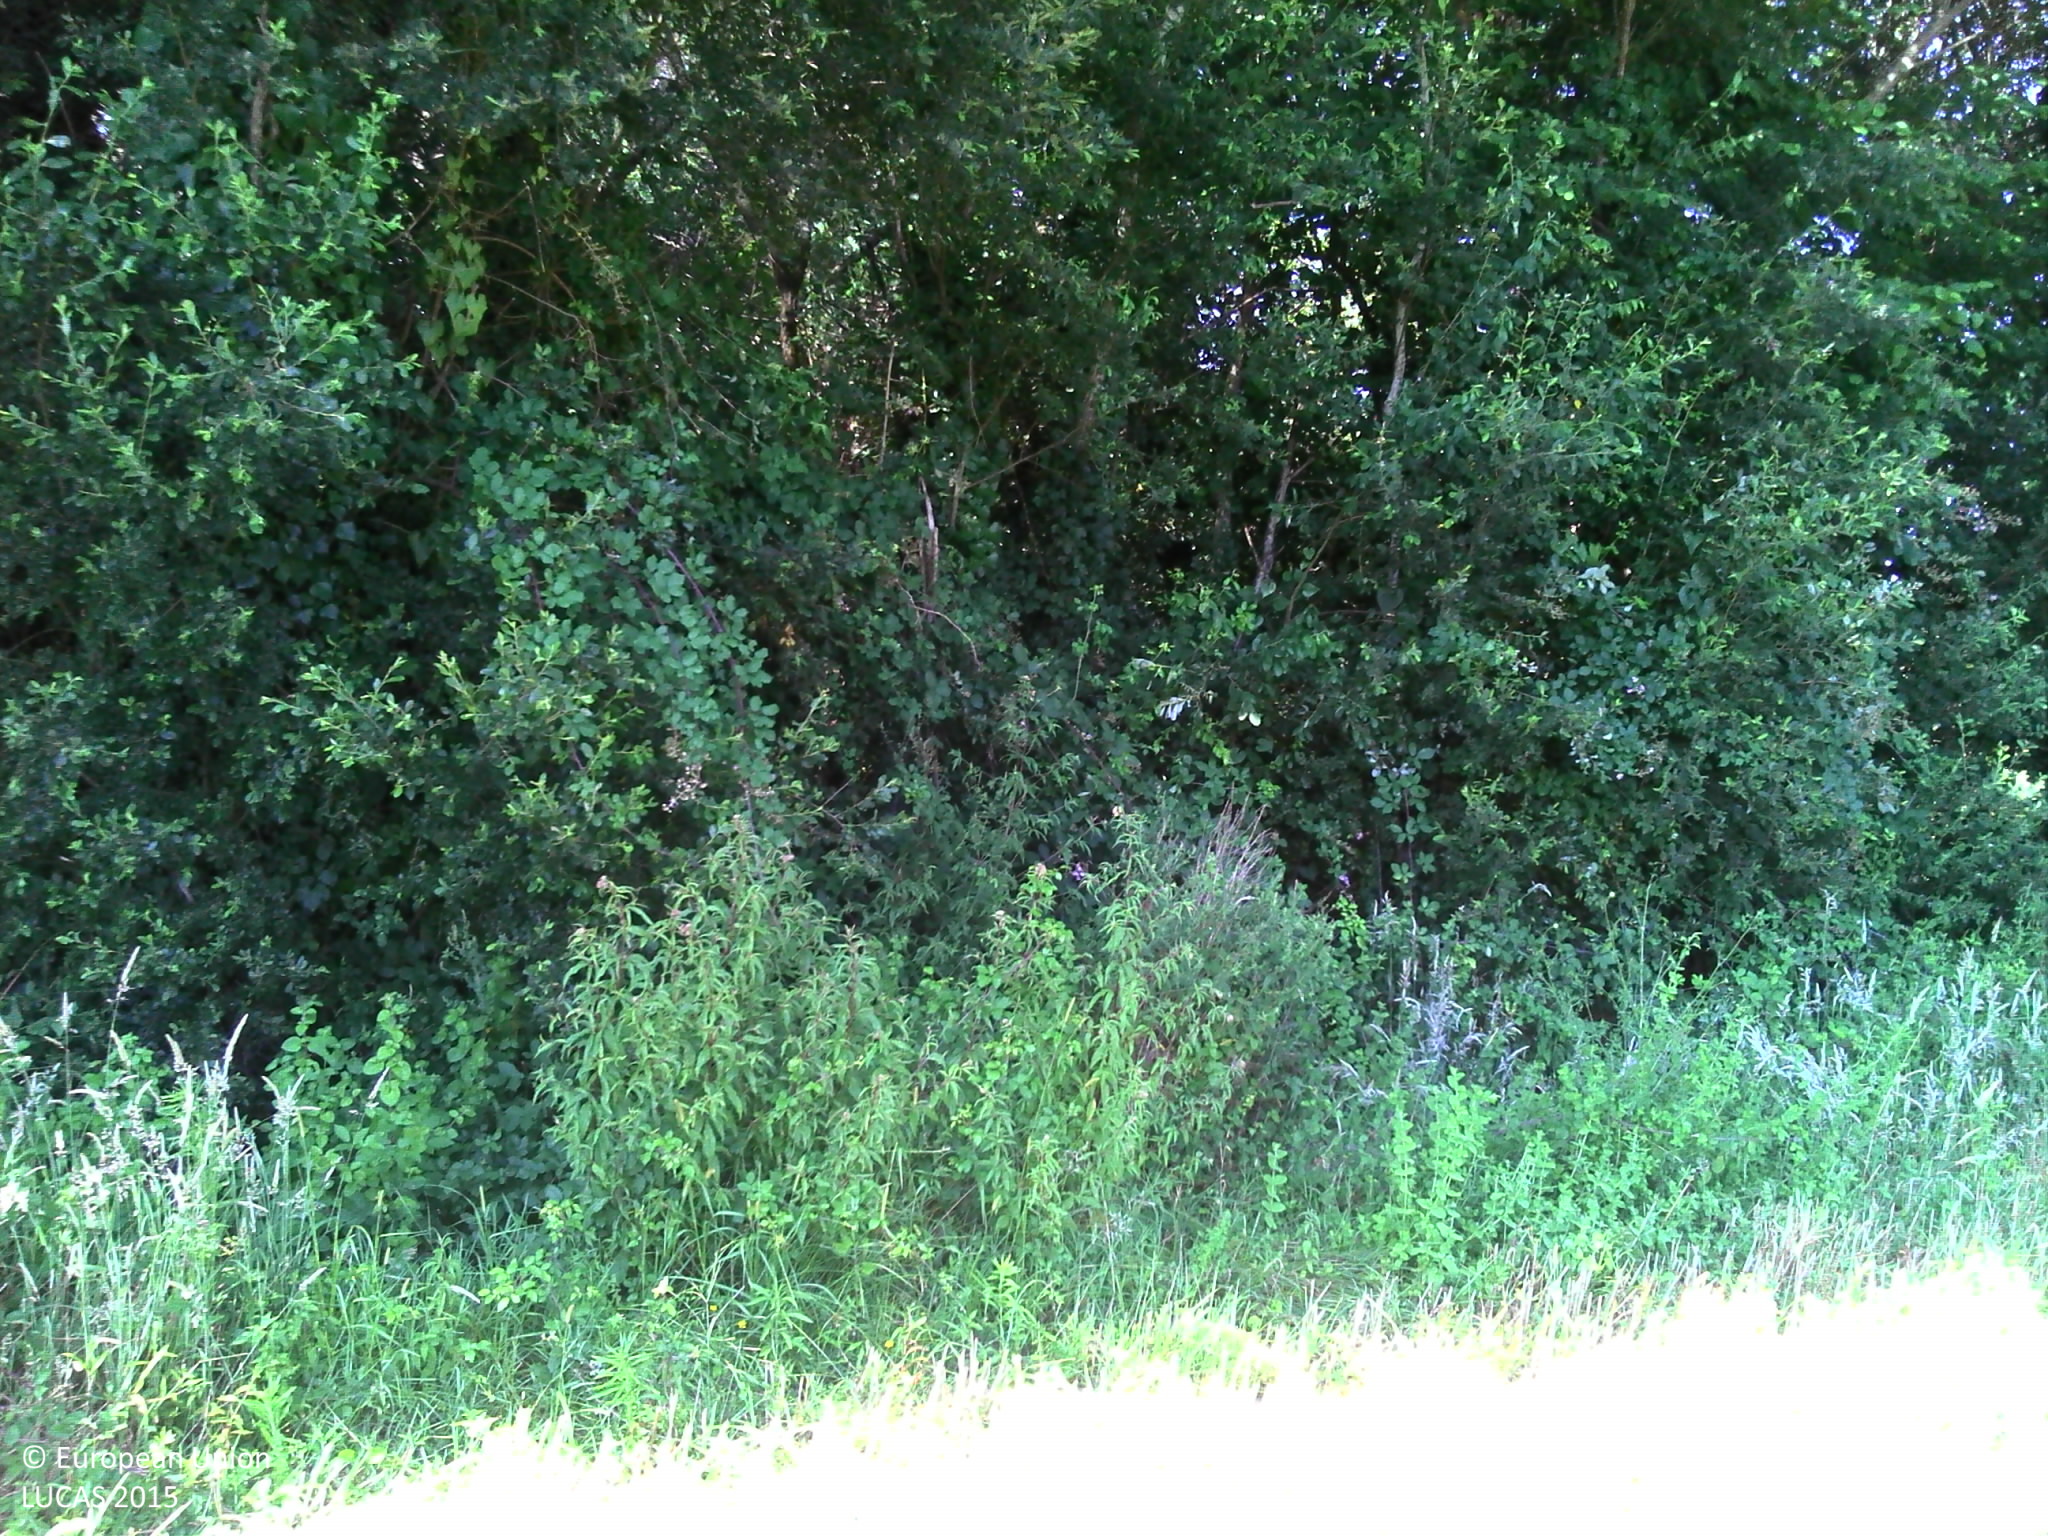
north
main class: Cropland
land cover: Temporary grasslands
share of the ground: > 75 %
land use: Agriculture (excluding fallow land and kitchen gardens)
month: July
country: FR
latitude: 43.6936
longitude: -1.1457
